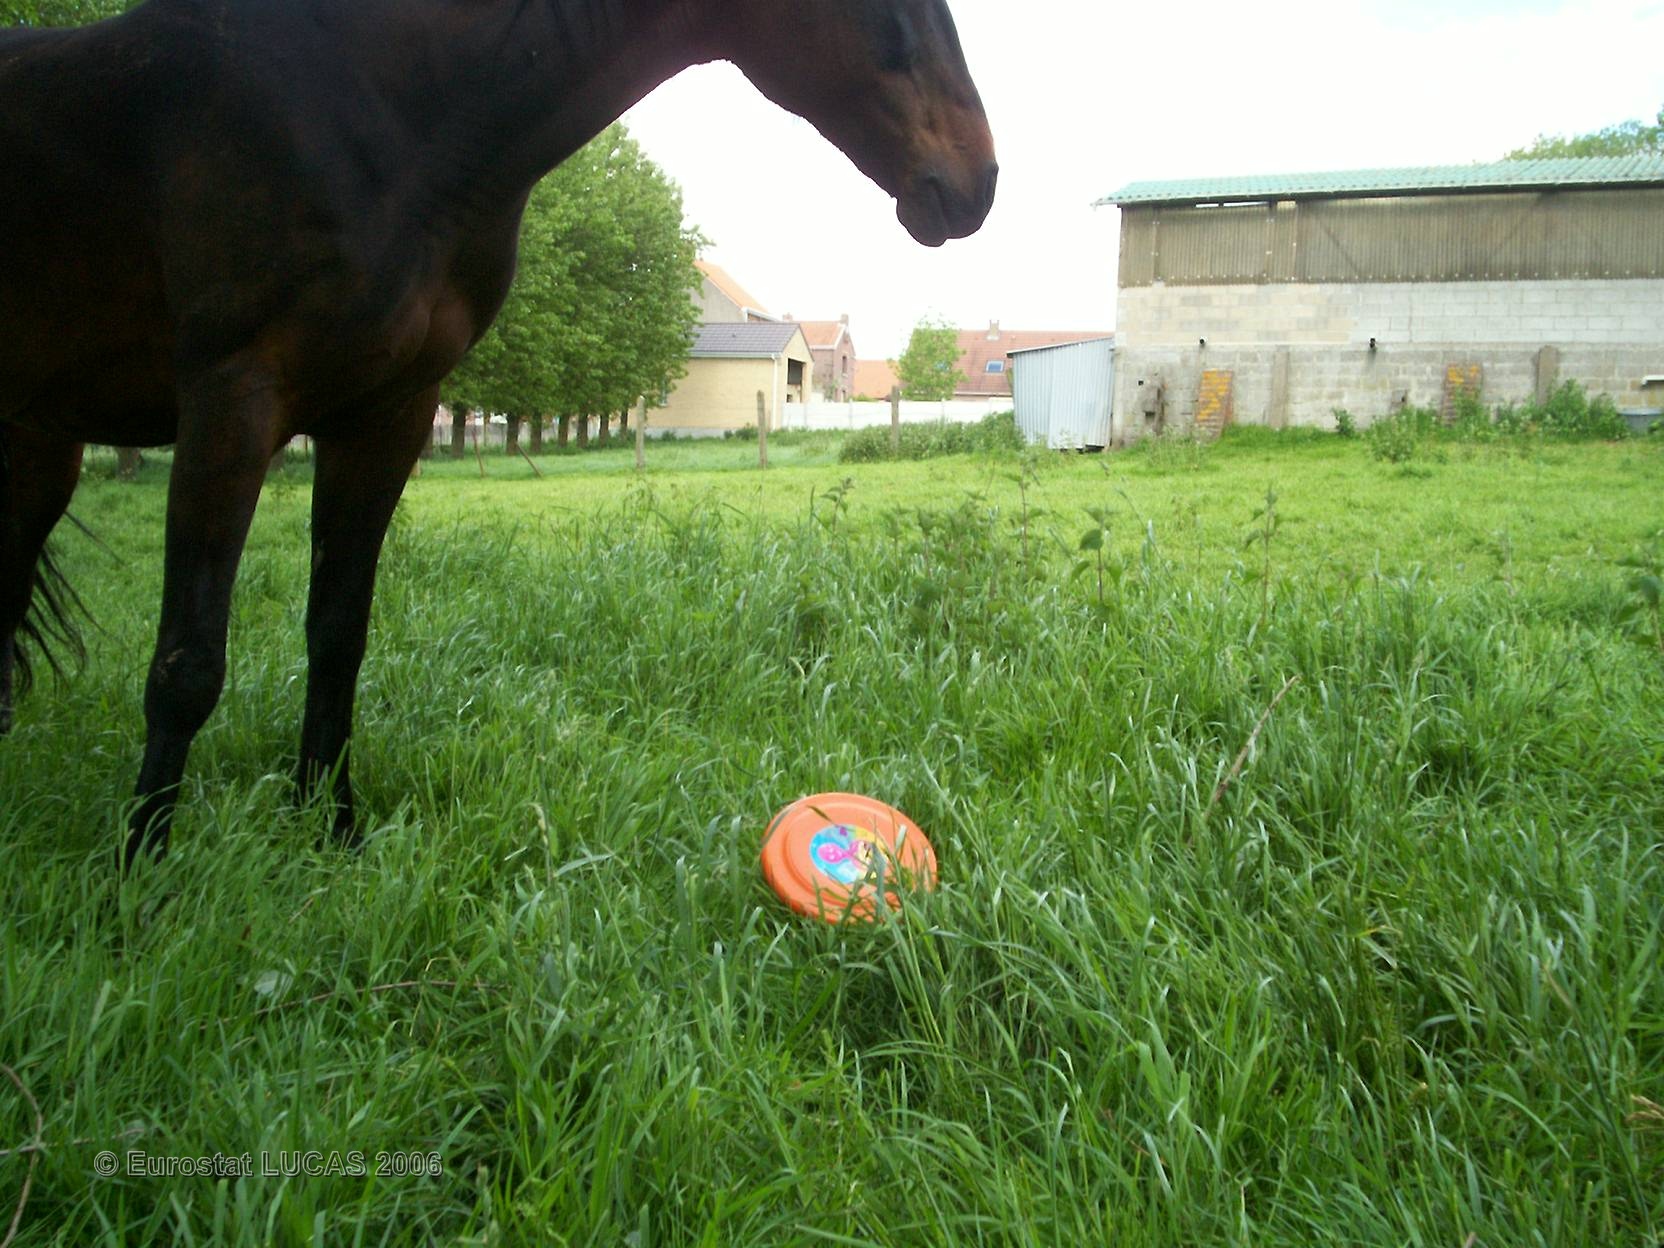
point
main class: Grassland
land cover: Grassland with sparse tree/shrub cover
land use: Agriculture (excluding fallow land and kitchen gardens)
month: May
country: FR
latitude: 50.9117
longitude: 2.4918
